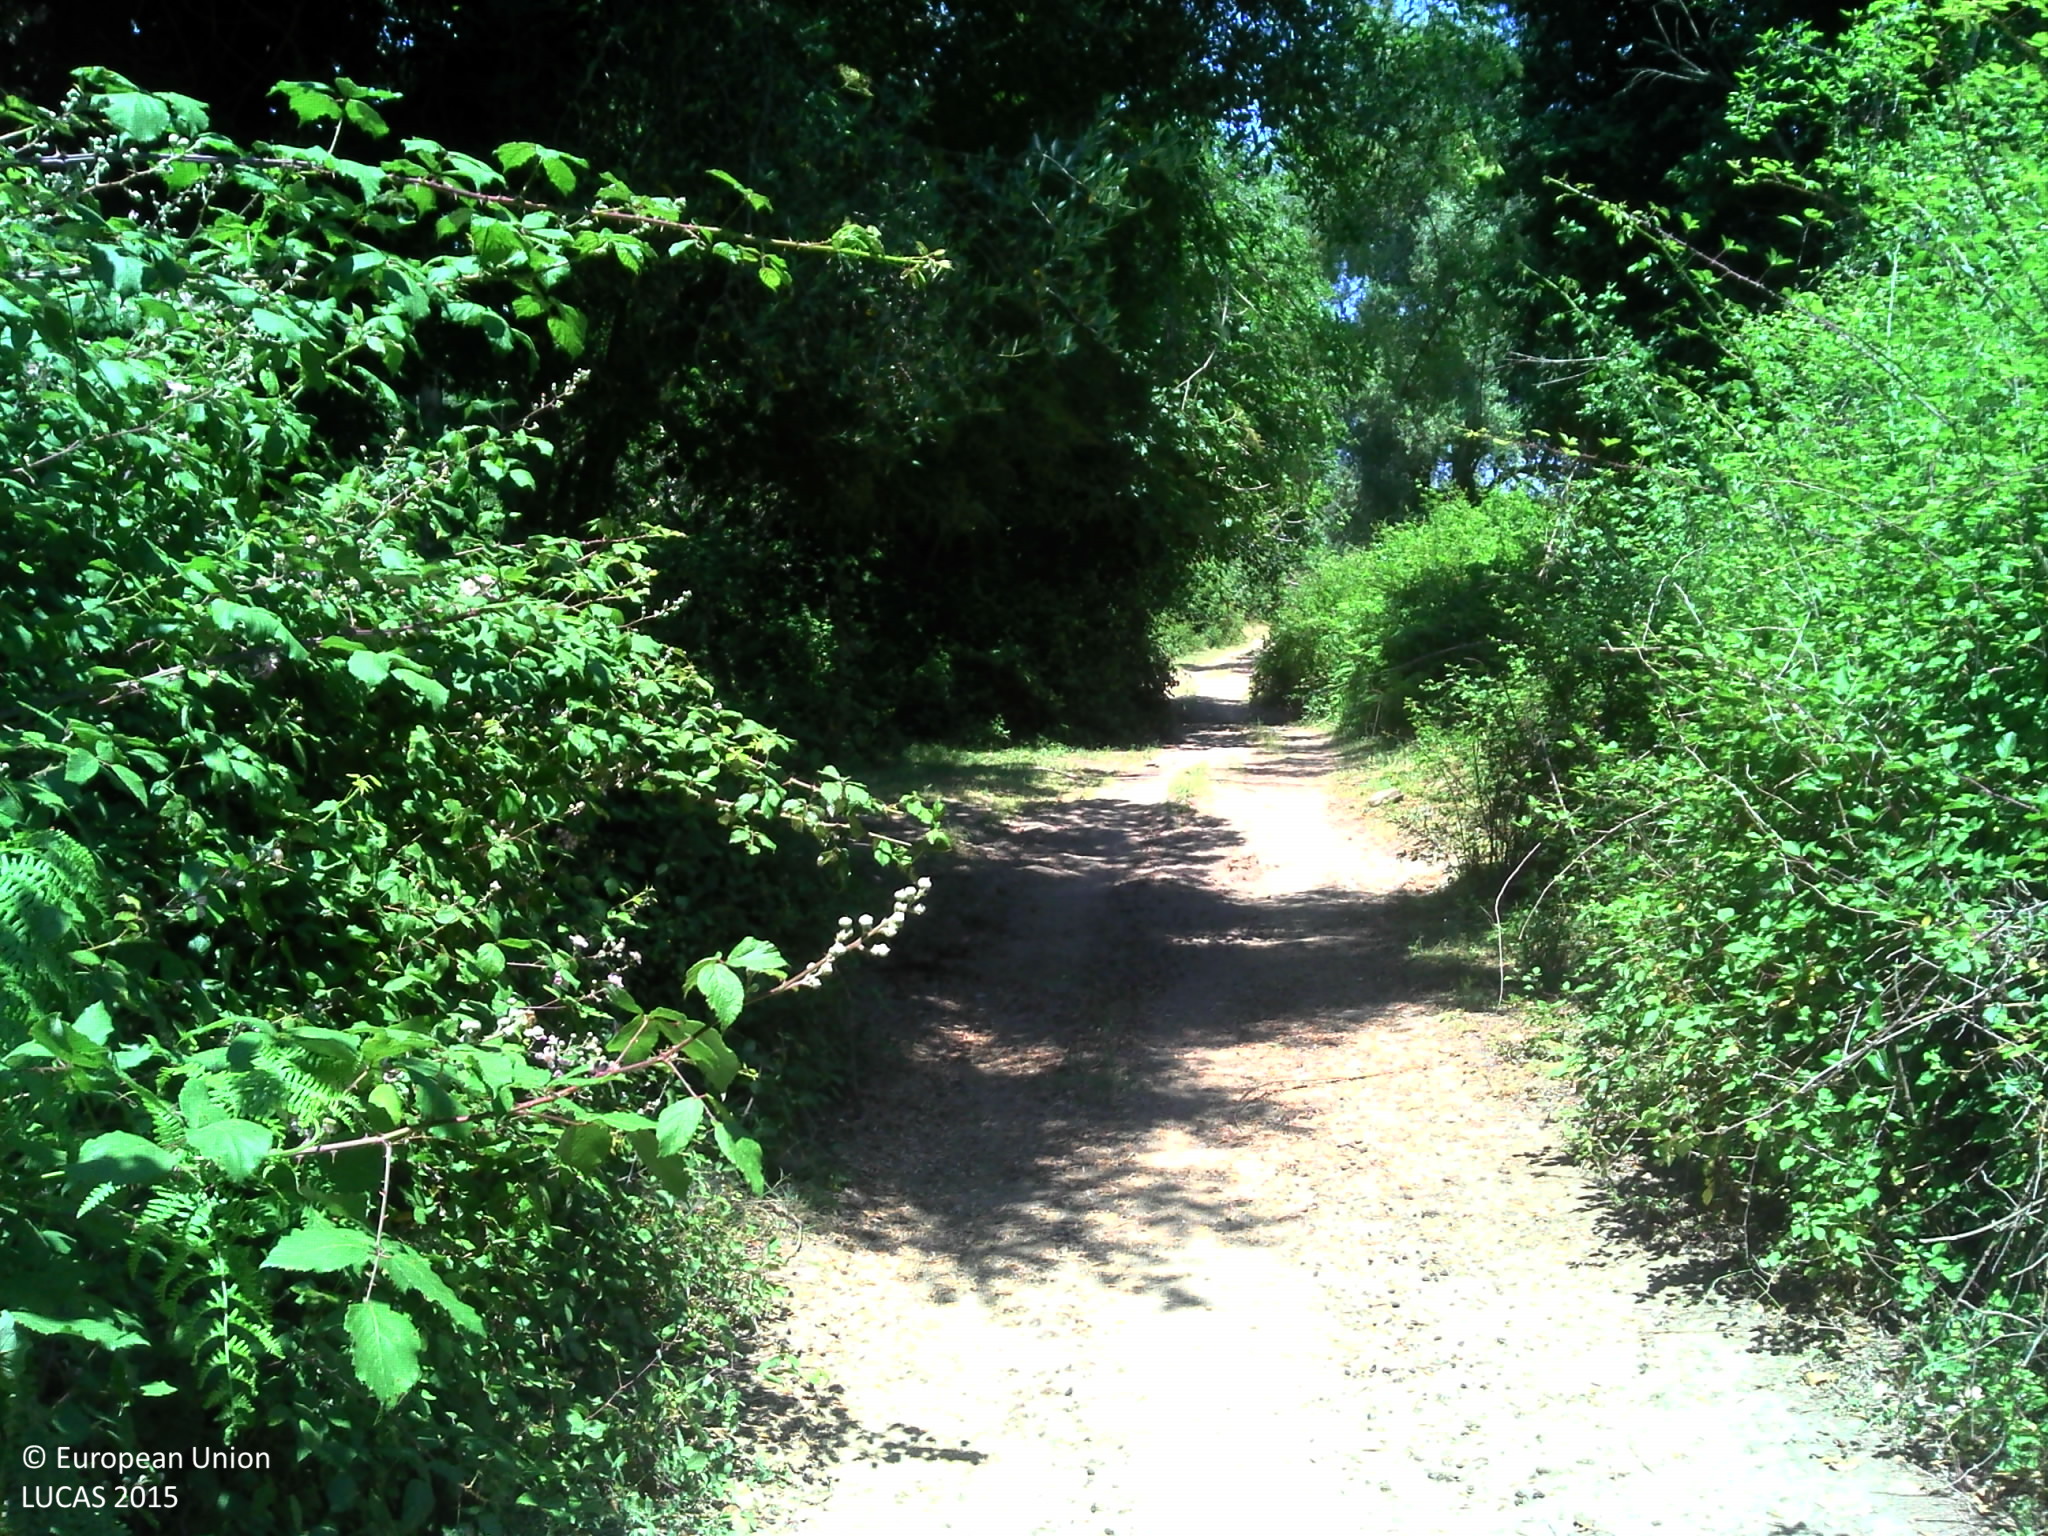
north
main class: Woodland
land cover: Broadleaved woodland
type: broadleaved evergreen forest
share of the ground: > 75 %
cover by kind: broadleaved forest trees 80 %, shrubs 20 %
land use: Forestry
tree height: > 5 m
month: June
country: FR
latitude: 42.5973
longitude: 9.2834
